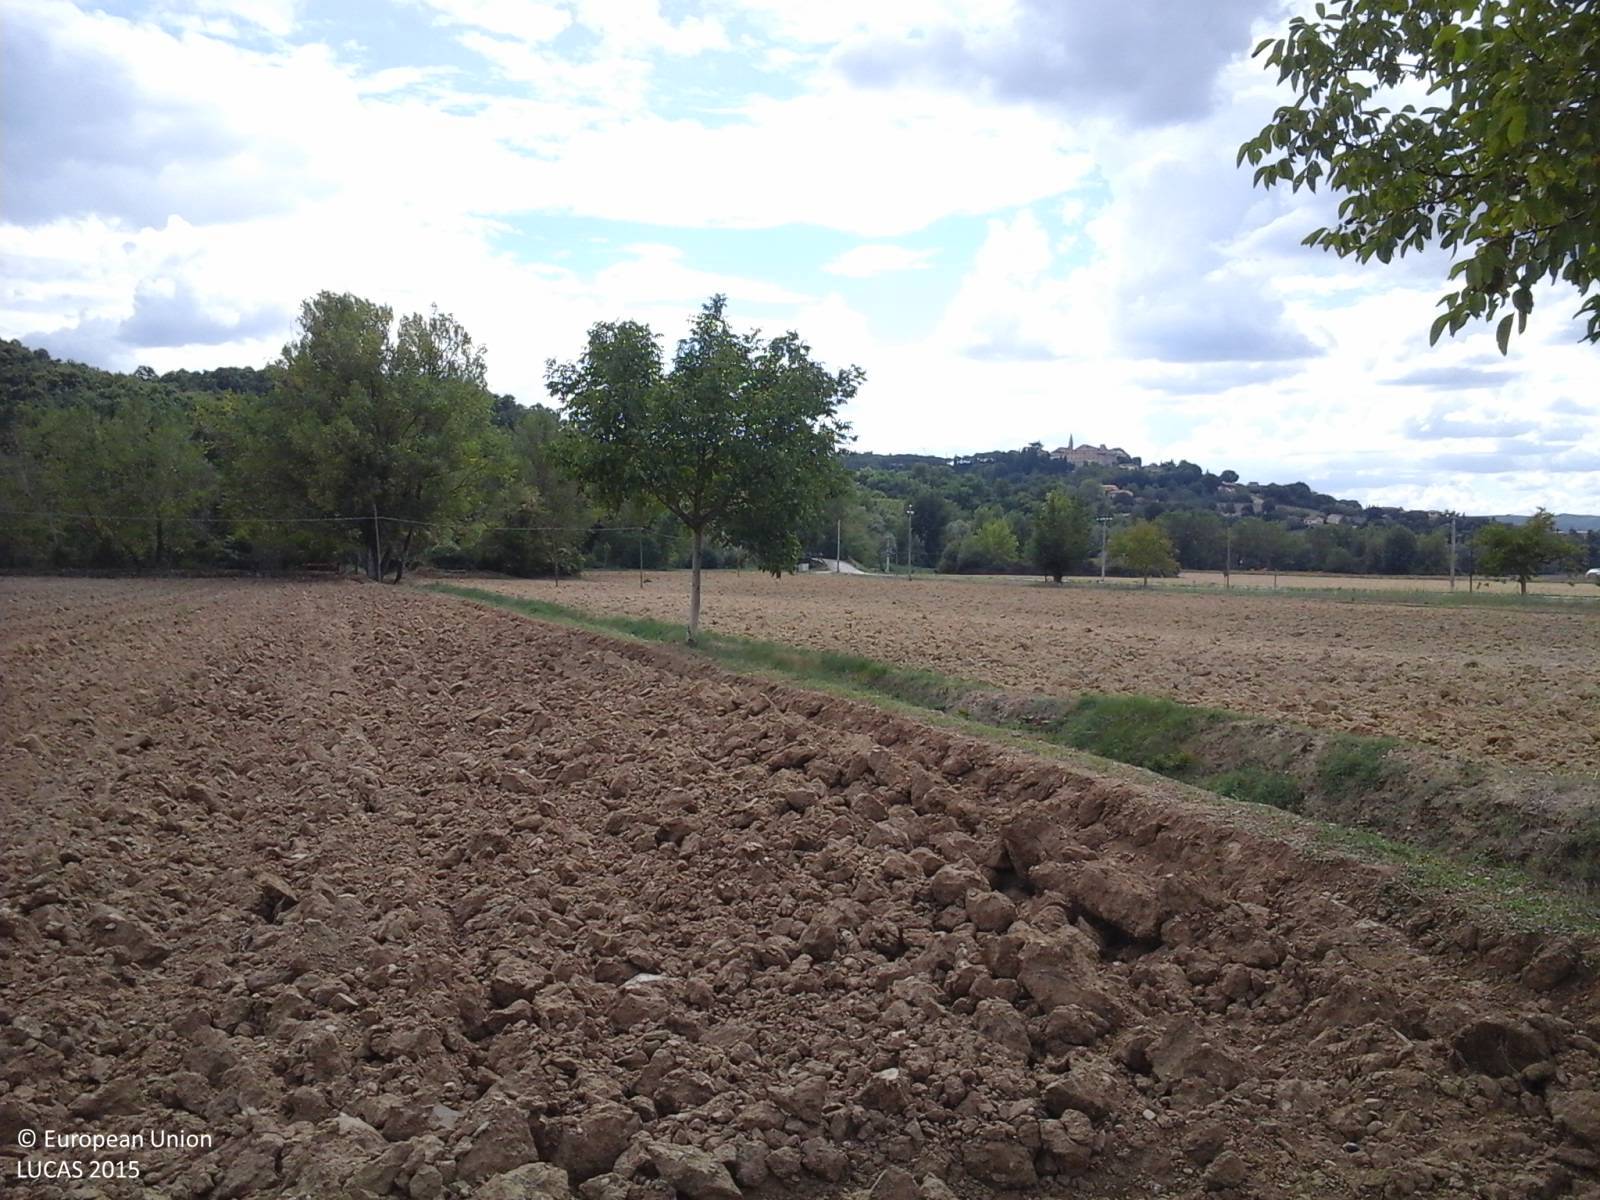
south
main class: Cropland
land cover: Barley
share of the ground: < 10 %
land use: Agriculture (excluding fallow land and kitchen gardens)
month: September
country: IT
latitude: 42.9326
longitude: 12.4067
